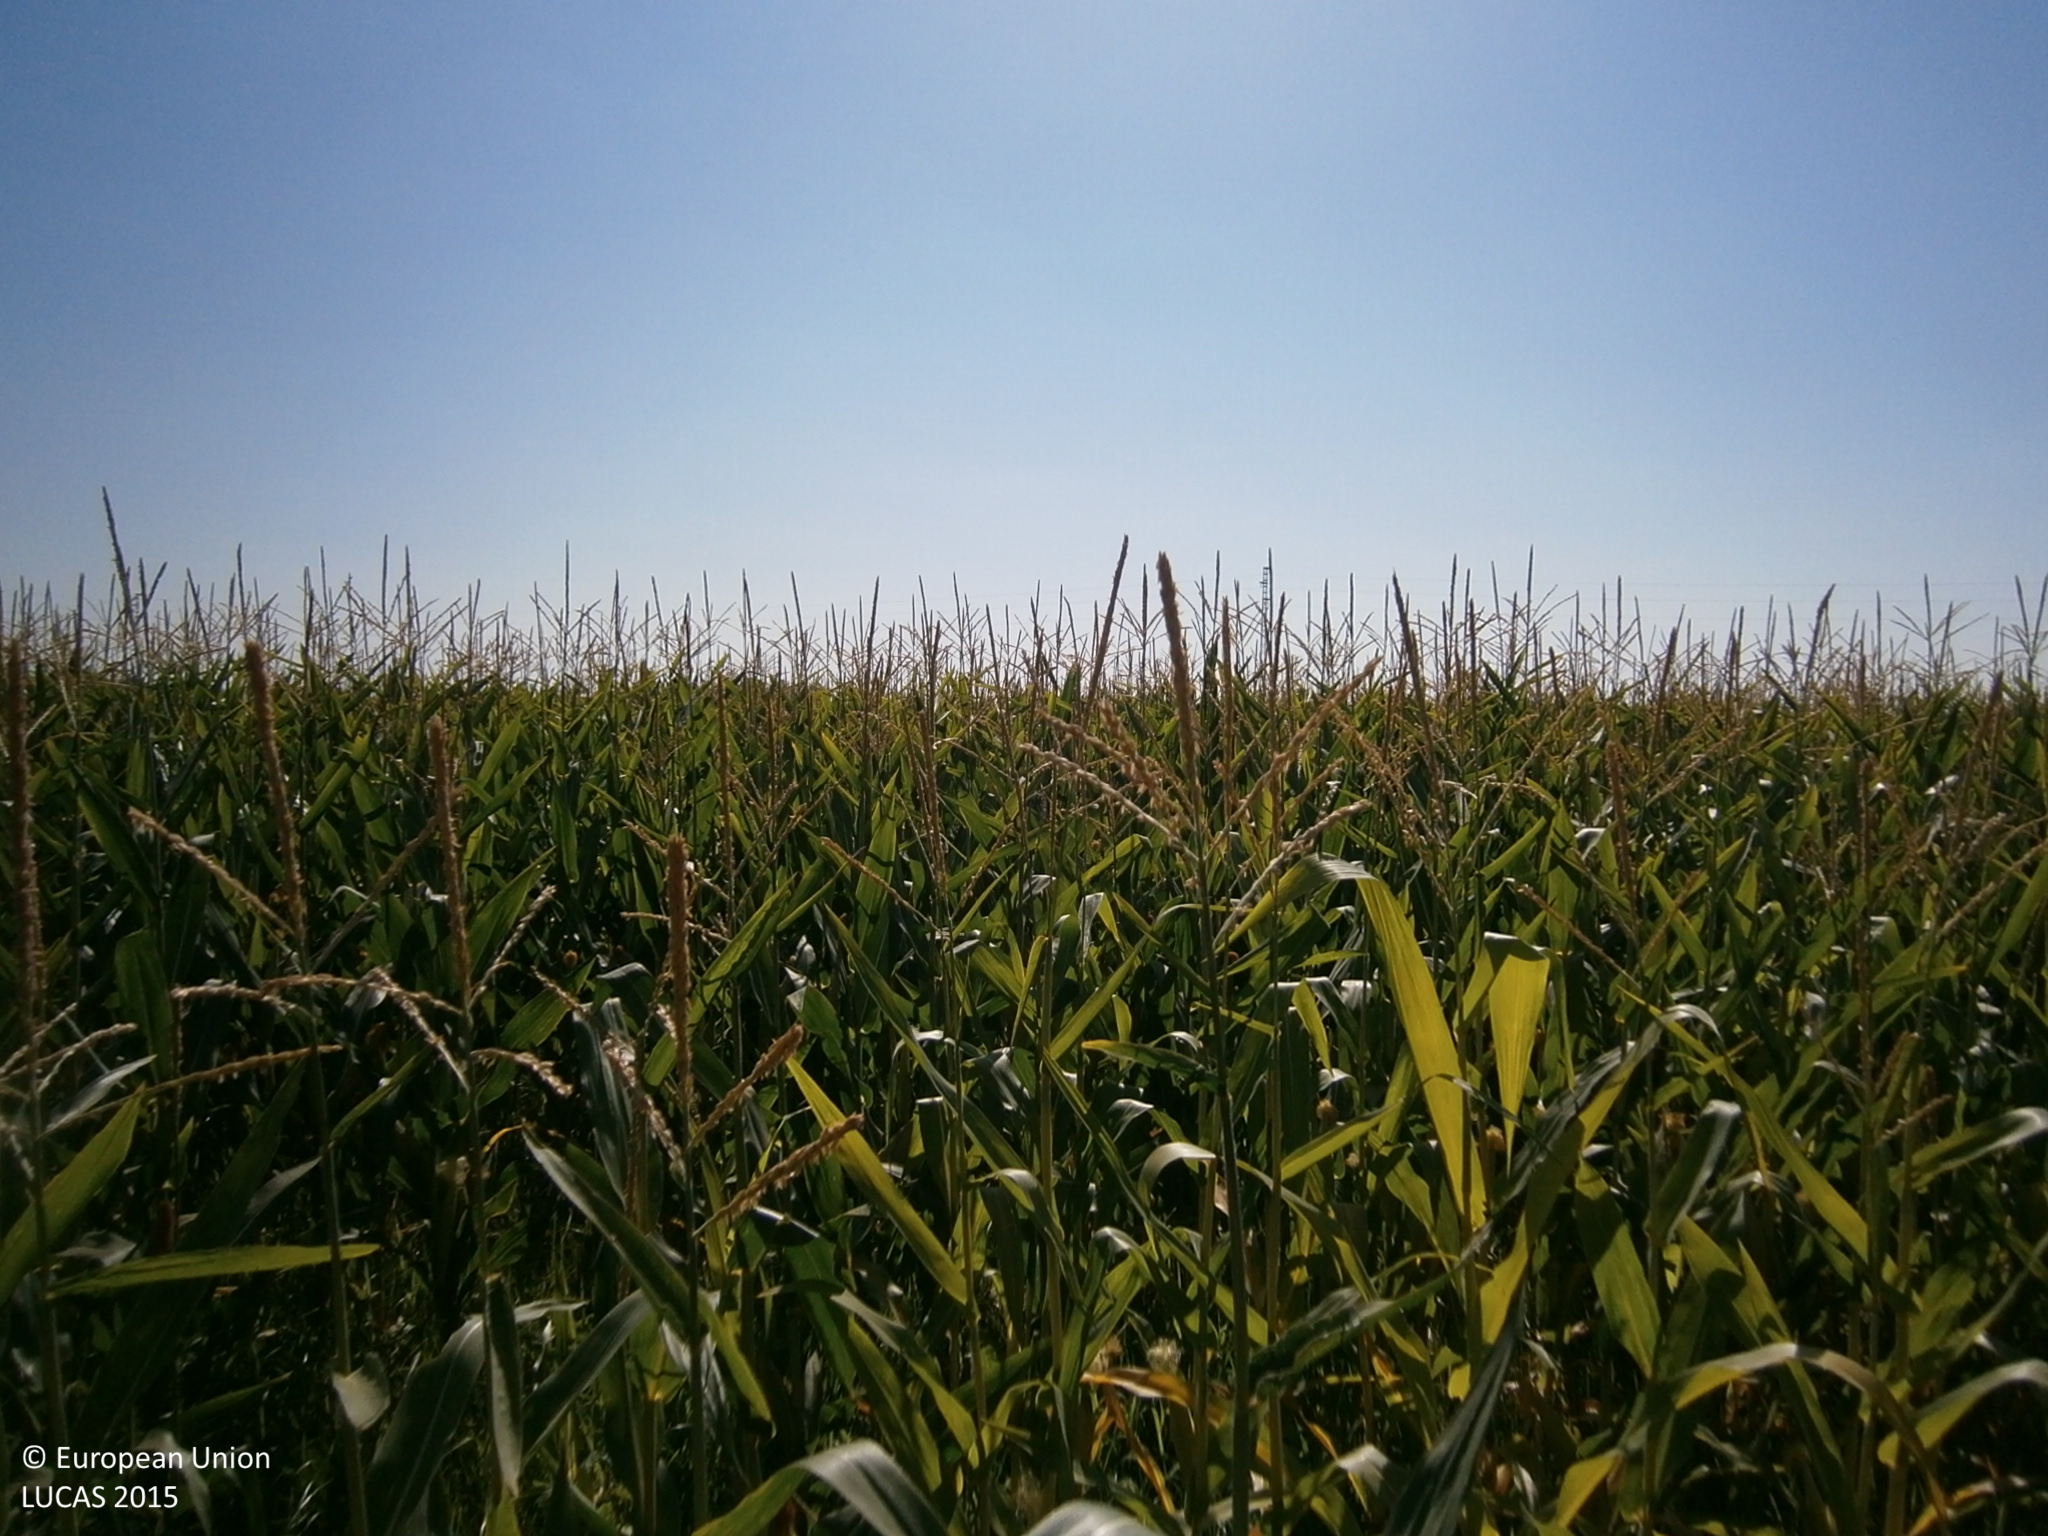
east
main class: Cropland
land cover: Maize
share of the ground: > 75 %
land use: Agriculture (excluding fallow land and kitchen gardens)
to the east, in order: Maize; Shruby margins; Rivers and streams; Tomatoes; Electric lines; Tomatoes
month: July
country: ES
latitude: 38.9069
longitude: -6.9640
